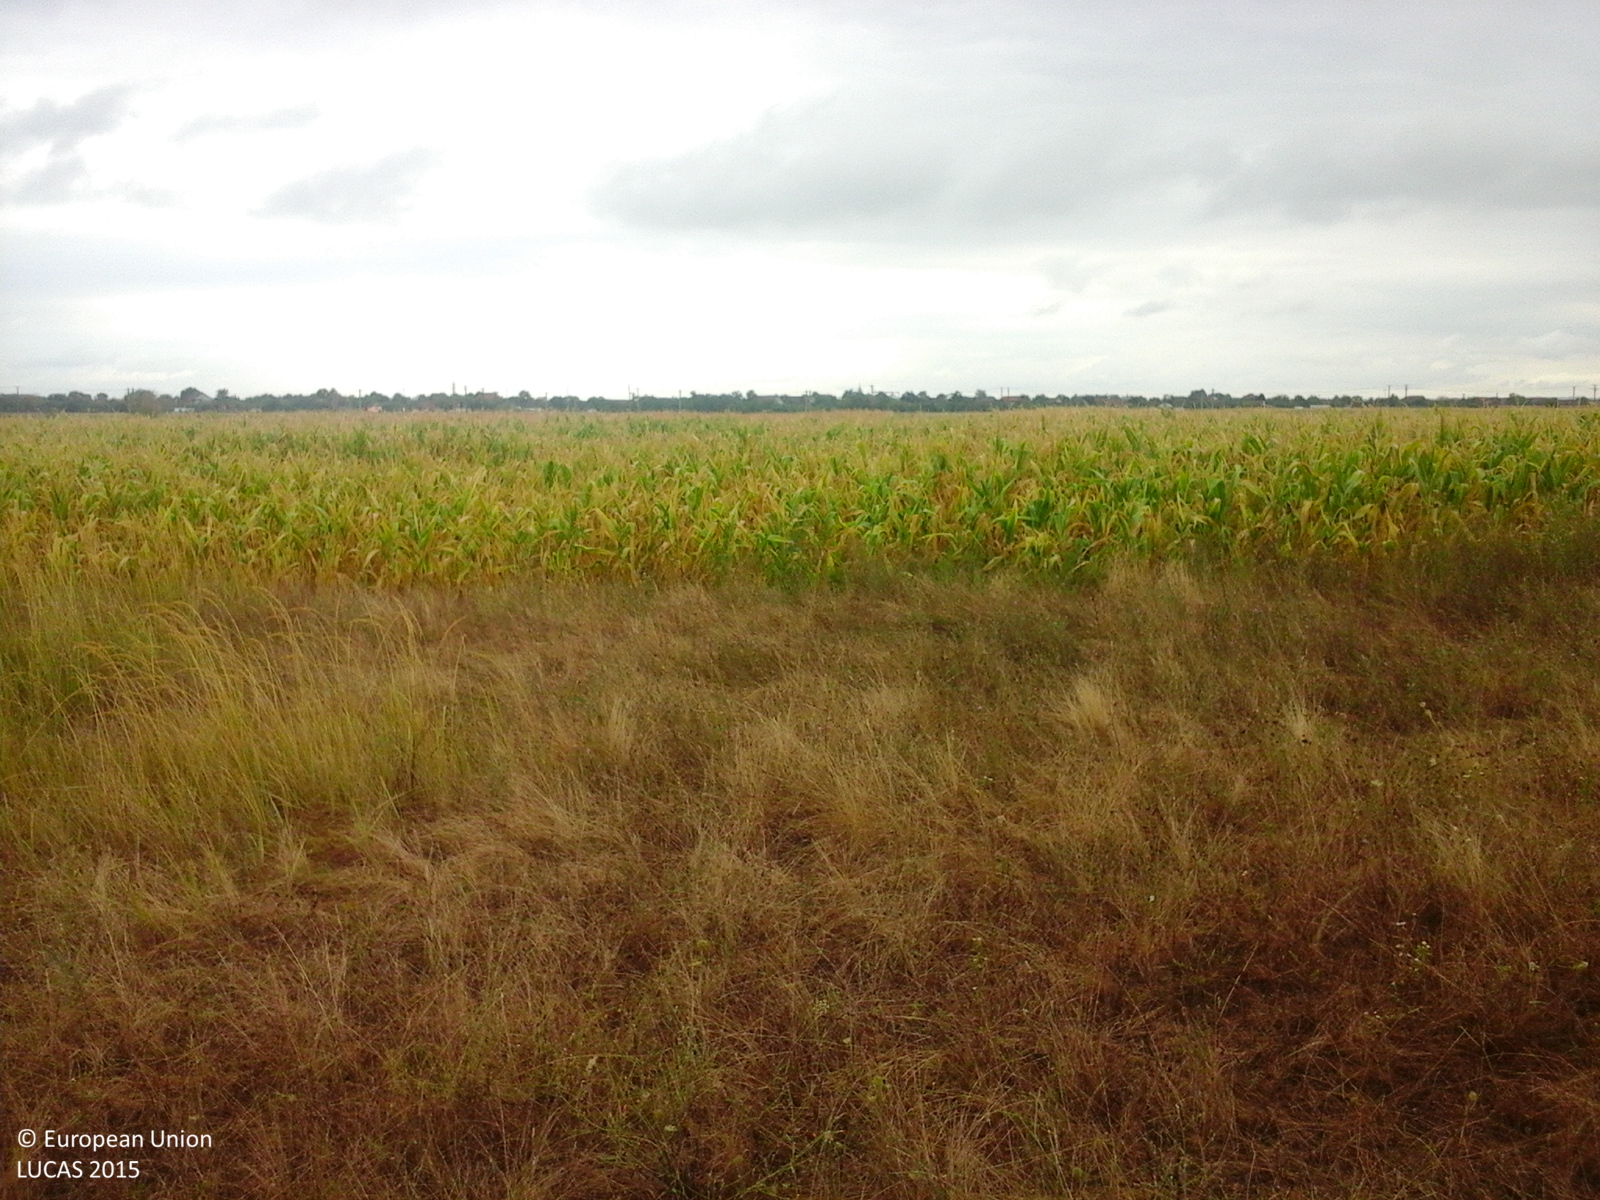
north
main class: Grassland
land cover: Grassland without tree/shrub cover
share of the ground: > 75 %
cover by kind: herbaceous plants 100 %
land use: Agriculture (excluding fallow land and kitchen gardens)
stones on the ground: < 10 %
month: August
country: RO
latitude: 45.7416
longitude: 21.3812
